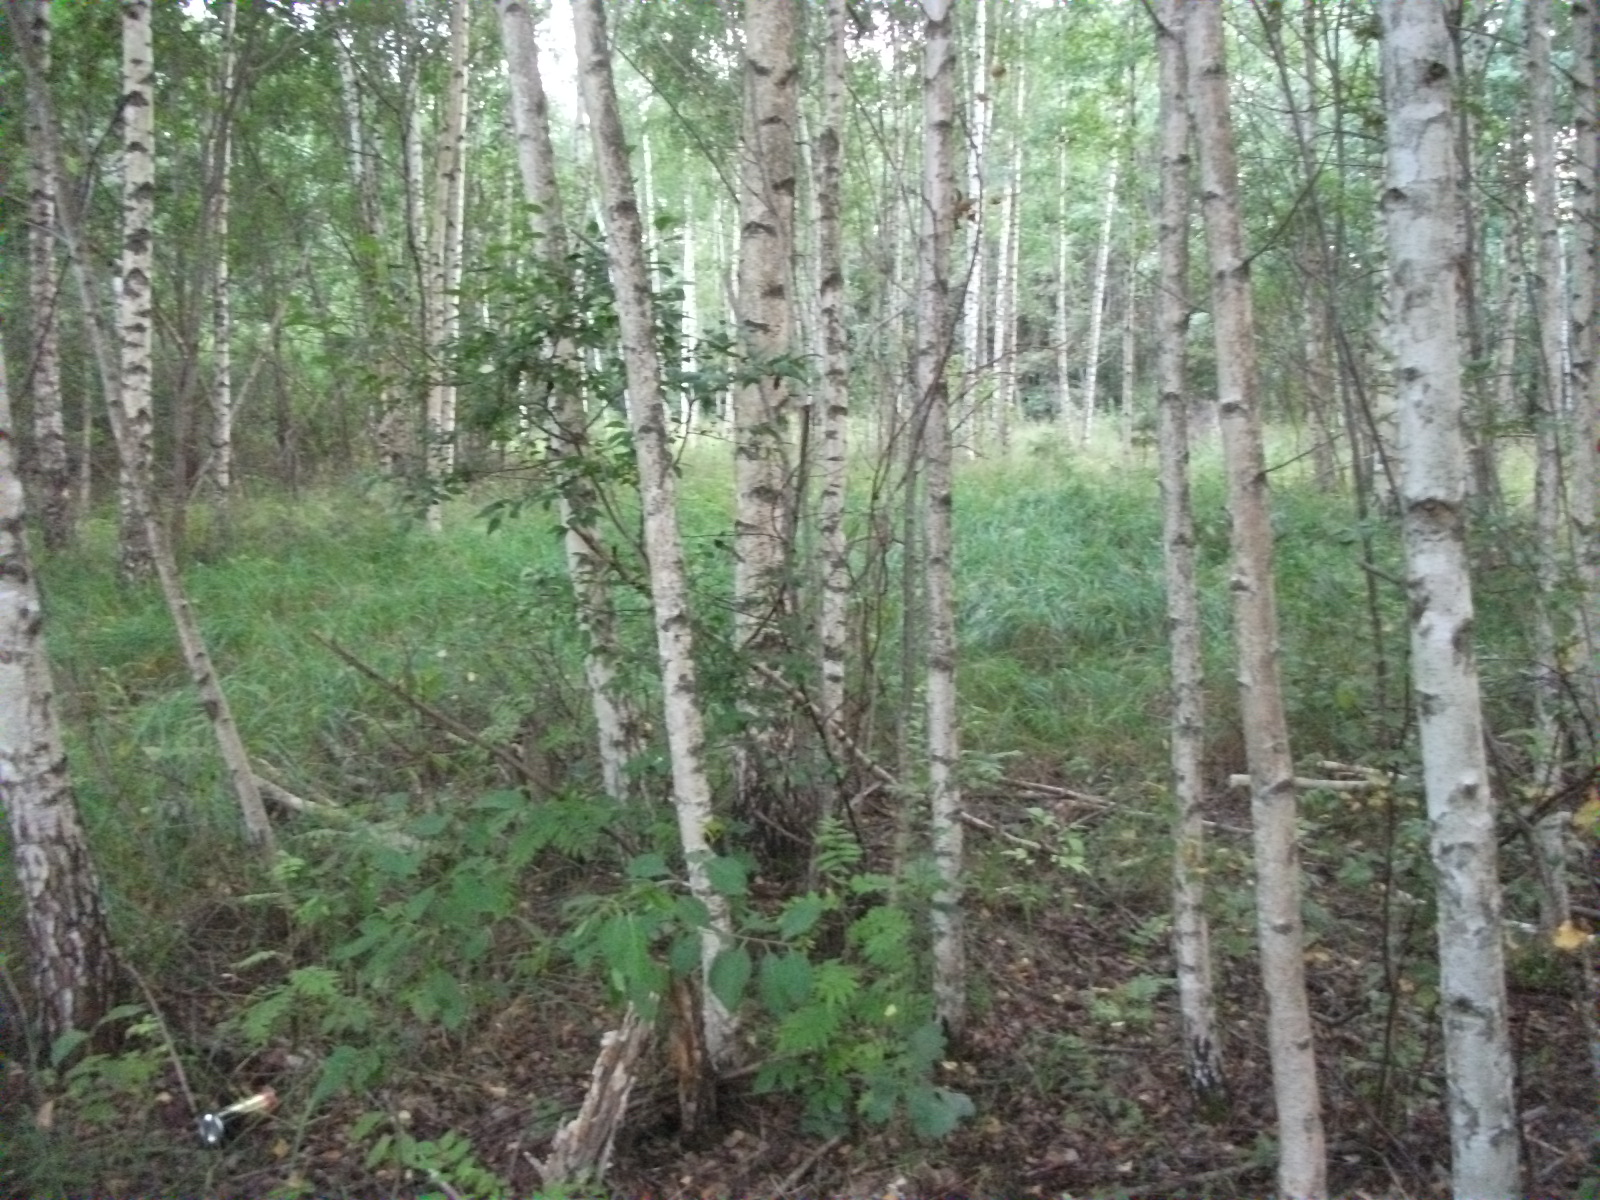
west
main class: Woodland
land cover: Broadleaved woodland
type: non-riverine alder, birch or aspen forest
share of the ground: > 75 %
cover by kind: broadleaved forest trees 80 %, unconsolidated bare surface 10 %, herbaceous plants 5 %
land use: Forestry
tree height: > 5 m
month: August
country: LV
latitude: 56.7662
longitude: 26.4901
